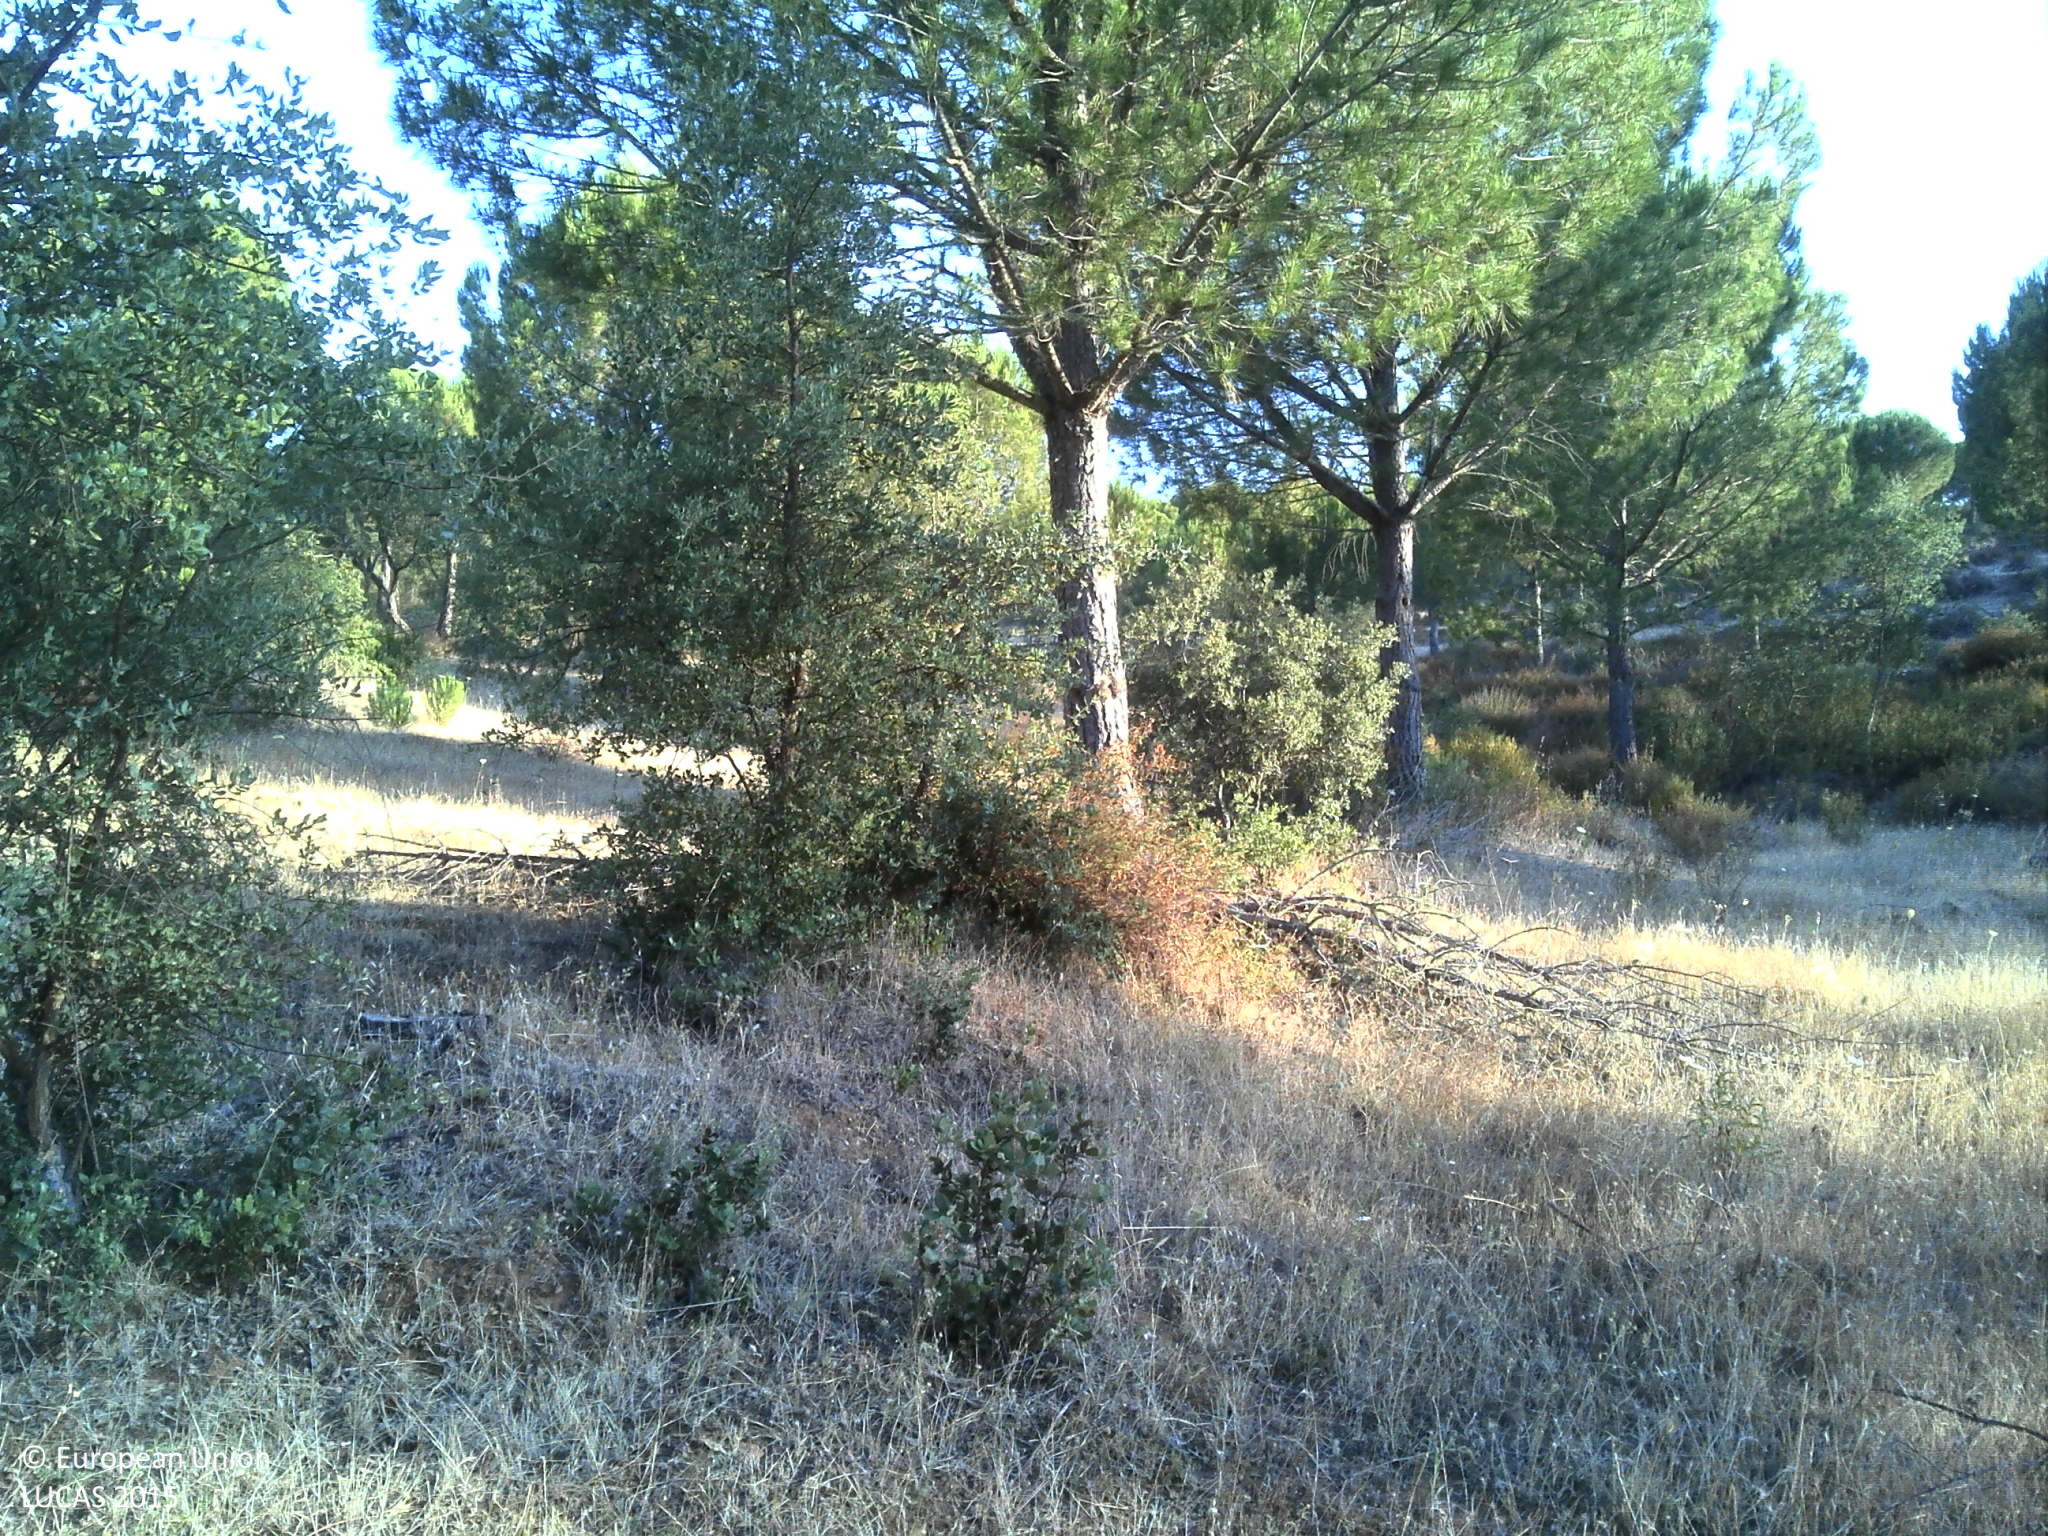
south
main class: Woodland
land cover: Other mixed woodland
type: broadleaved evergreen forest
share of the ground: 50 - 75 %
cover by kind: broadleaved forest trees 50 %, coniferous forest trees 35 %, herbaceous plants 15 %
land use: Forestry
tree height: > 5 m
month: June
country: PT
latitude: 38.0722
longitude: -7.1924
